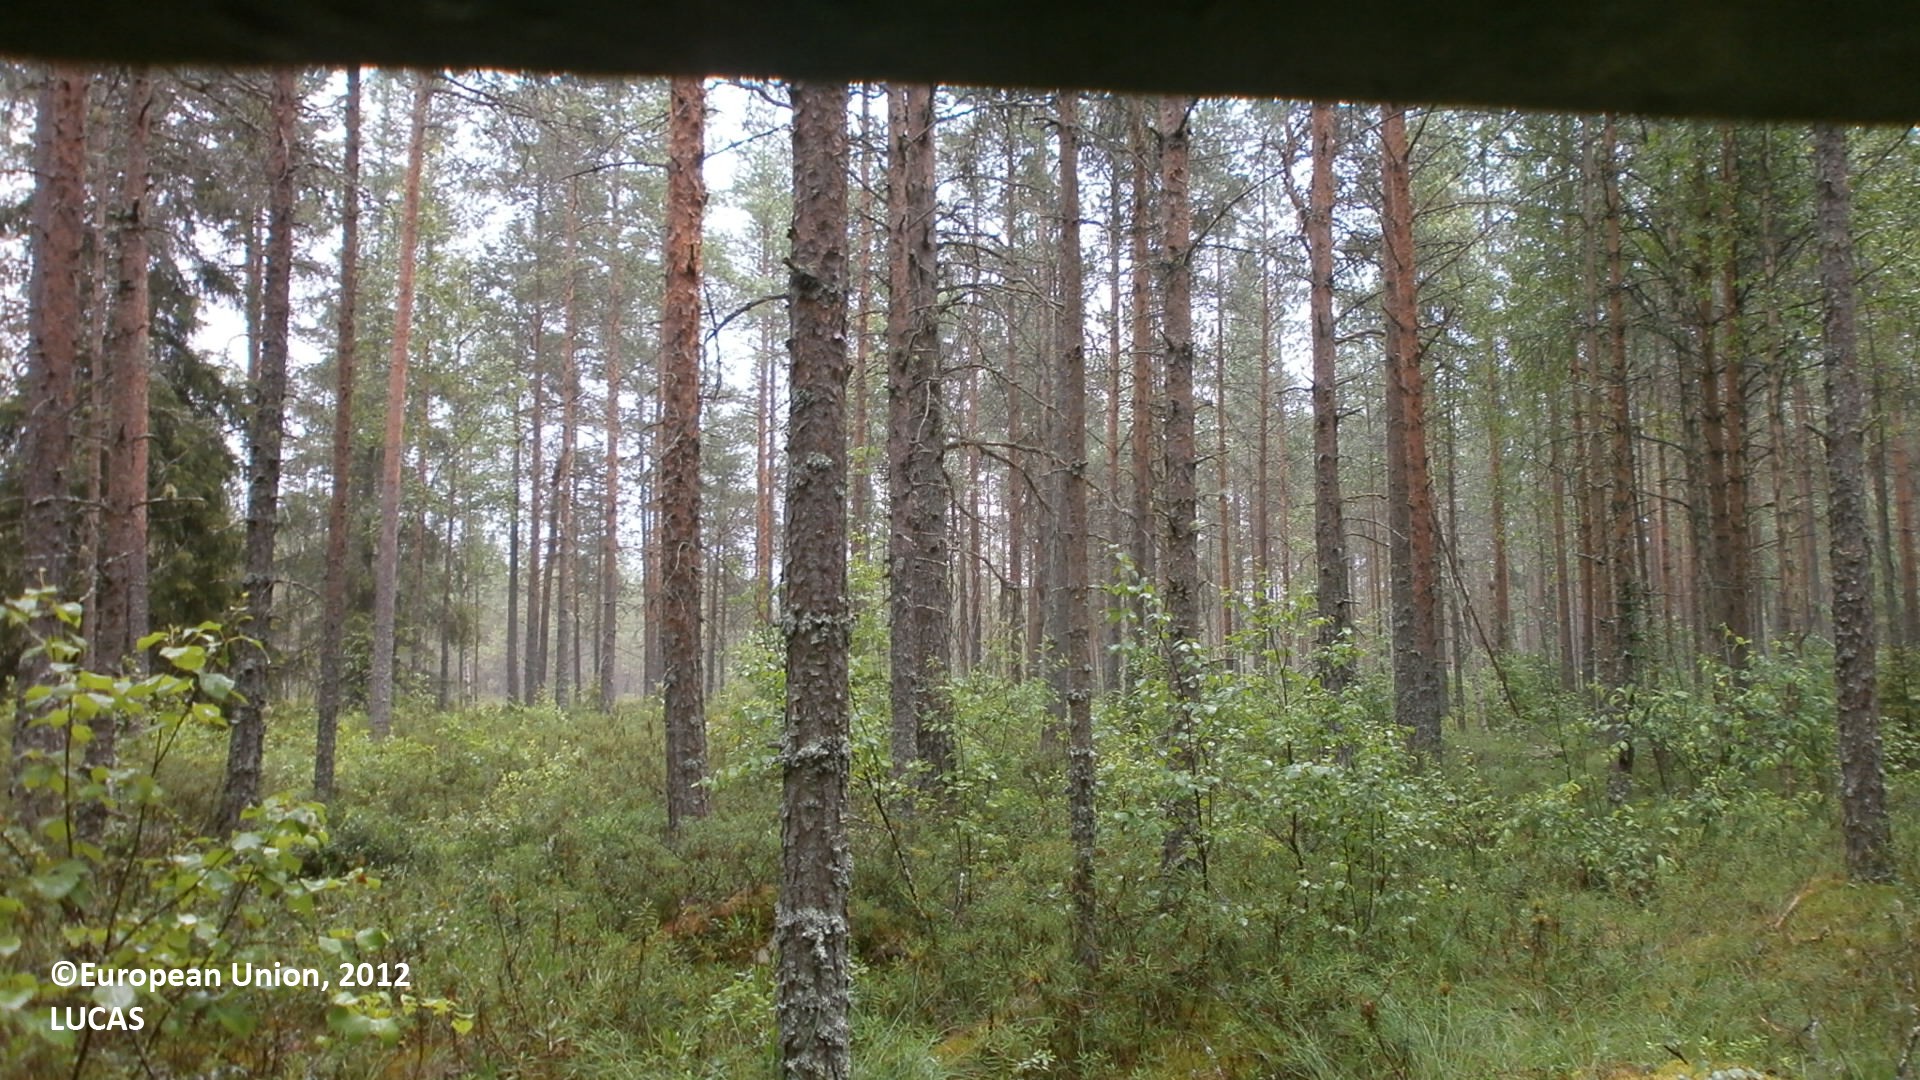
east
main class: Woodland
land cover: Pine dominated coniferous woodland
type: boreal forest
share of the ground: 50 - 75 %
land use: Forestry
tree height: > 5 m
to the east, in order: Pine dominated coniferous woodland; Ditches and canals; Pine dominated coniferous woodland; Ditches and canals; Pine dominated coniferous woodland; Ditches and canals; Pine dominated coniferous woodland; Tracks; Pine dominated coniferous woodland
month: July
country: FI
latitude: 64.0663
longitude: 23.8132
